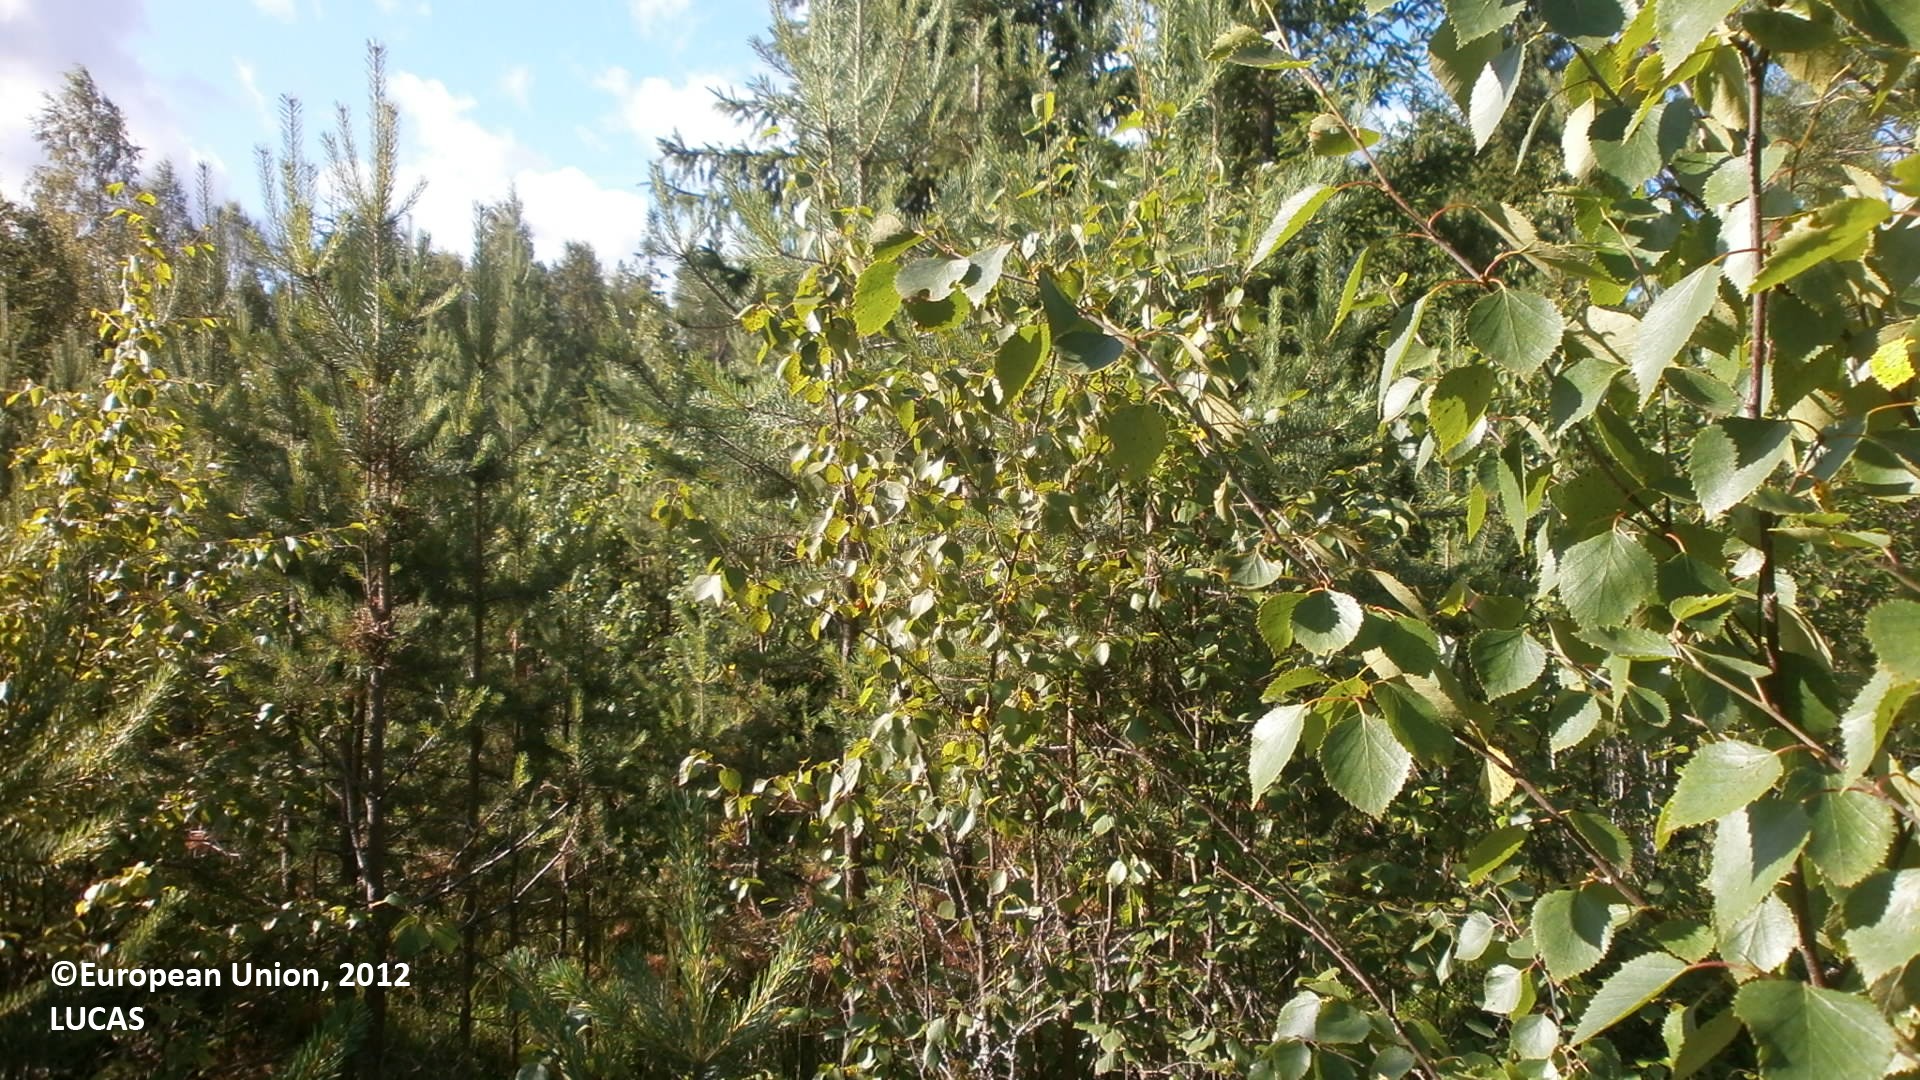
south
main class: Woodland
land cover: Pine dominated mixed woodland
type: boreal forest
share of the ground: 50 - 75 %
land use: Forestry
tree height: > 5 m
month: July
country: FI
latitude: 64.0764
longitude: 24.1103
